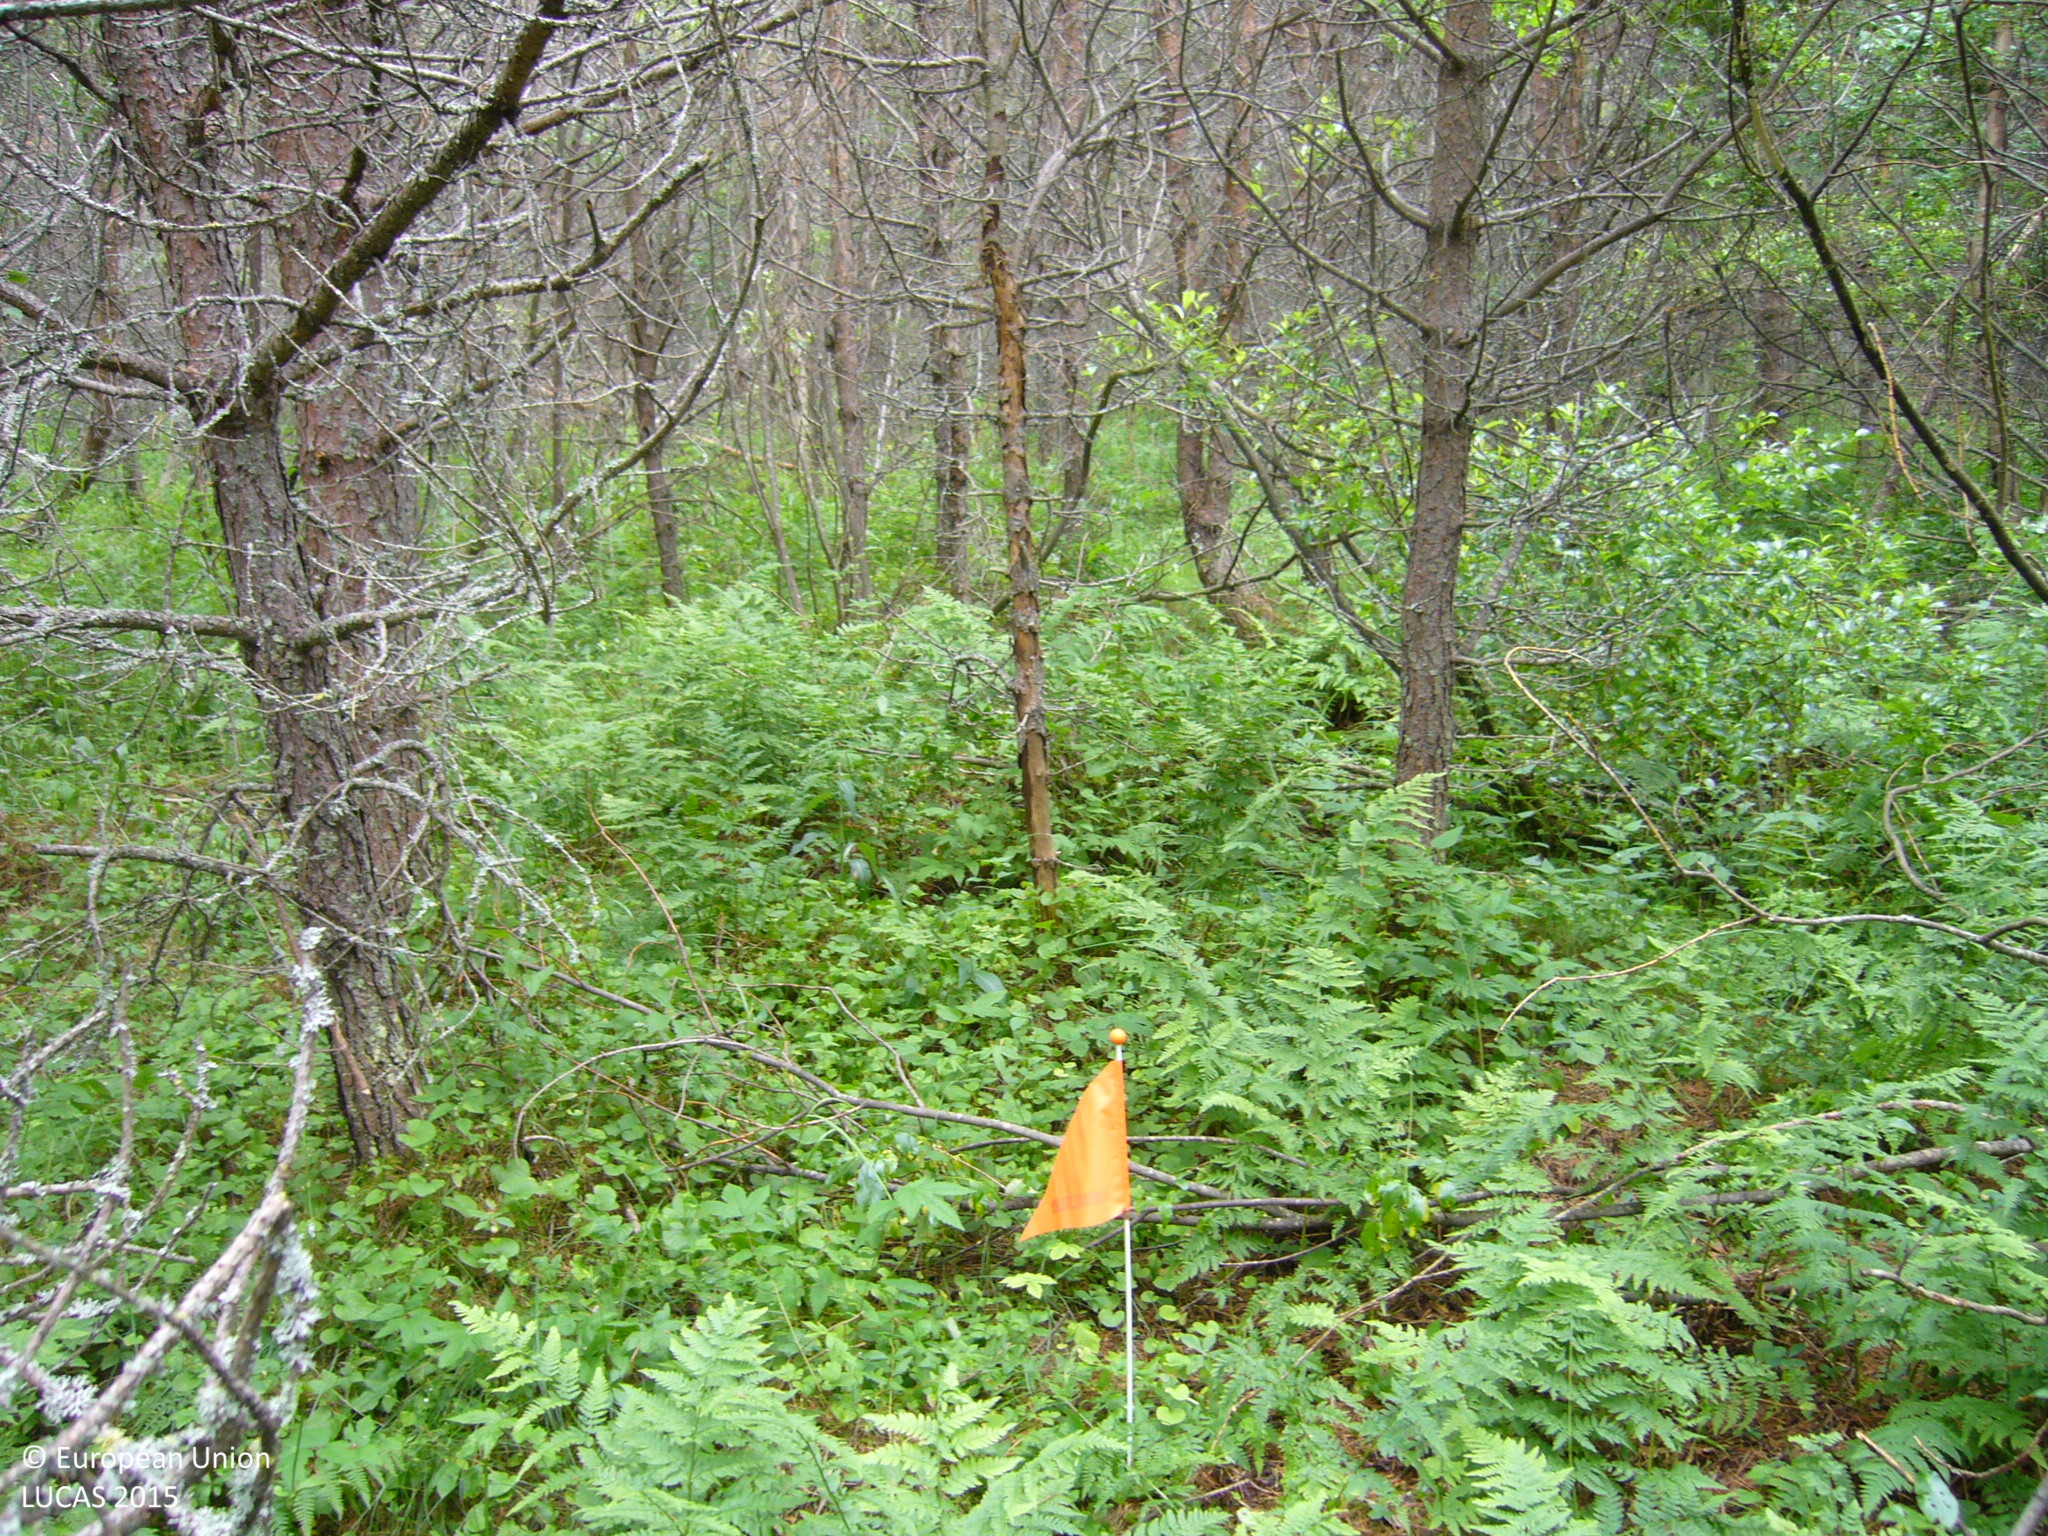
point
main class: Woodland
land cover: Pine dominated coniferous woodland
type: boreal forest
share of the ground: > 75 %
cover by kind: coniferous forest trees 80 %, shrubs 20 %
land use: Forestry
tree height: > 5 m
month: July
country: FI
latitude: 63.7433
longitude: 26.0155
